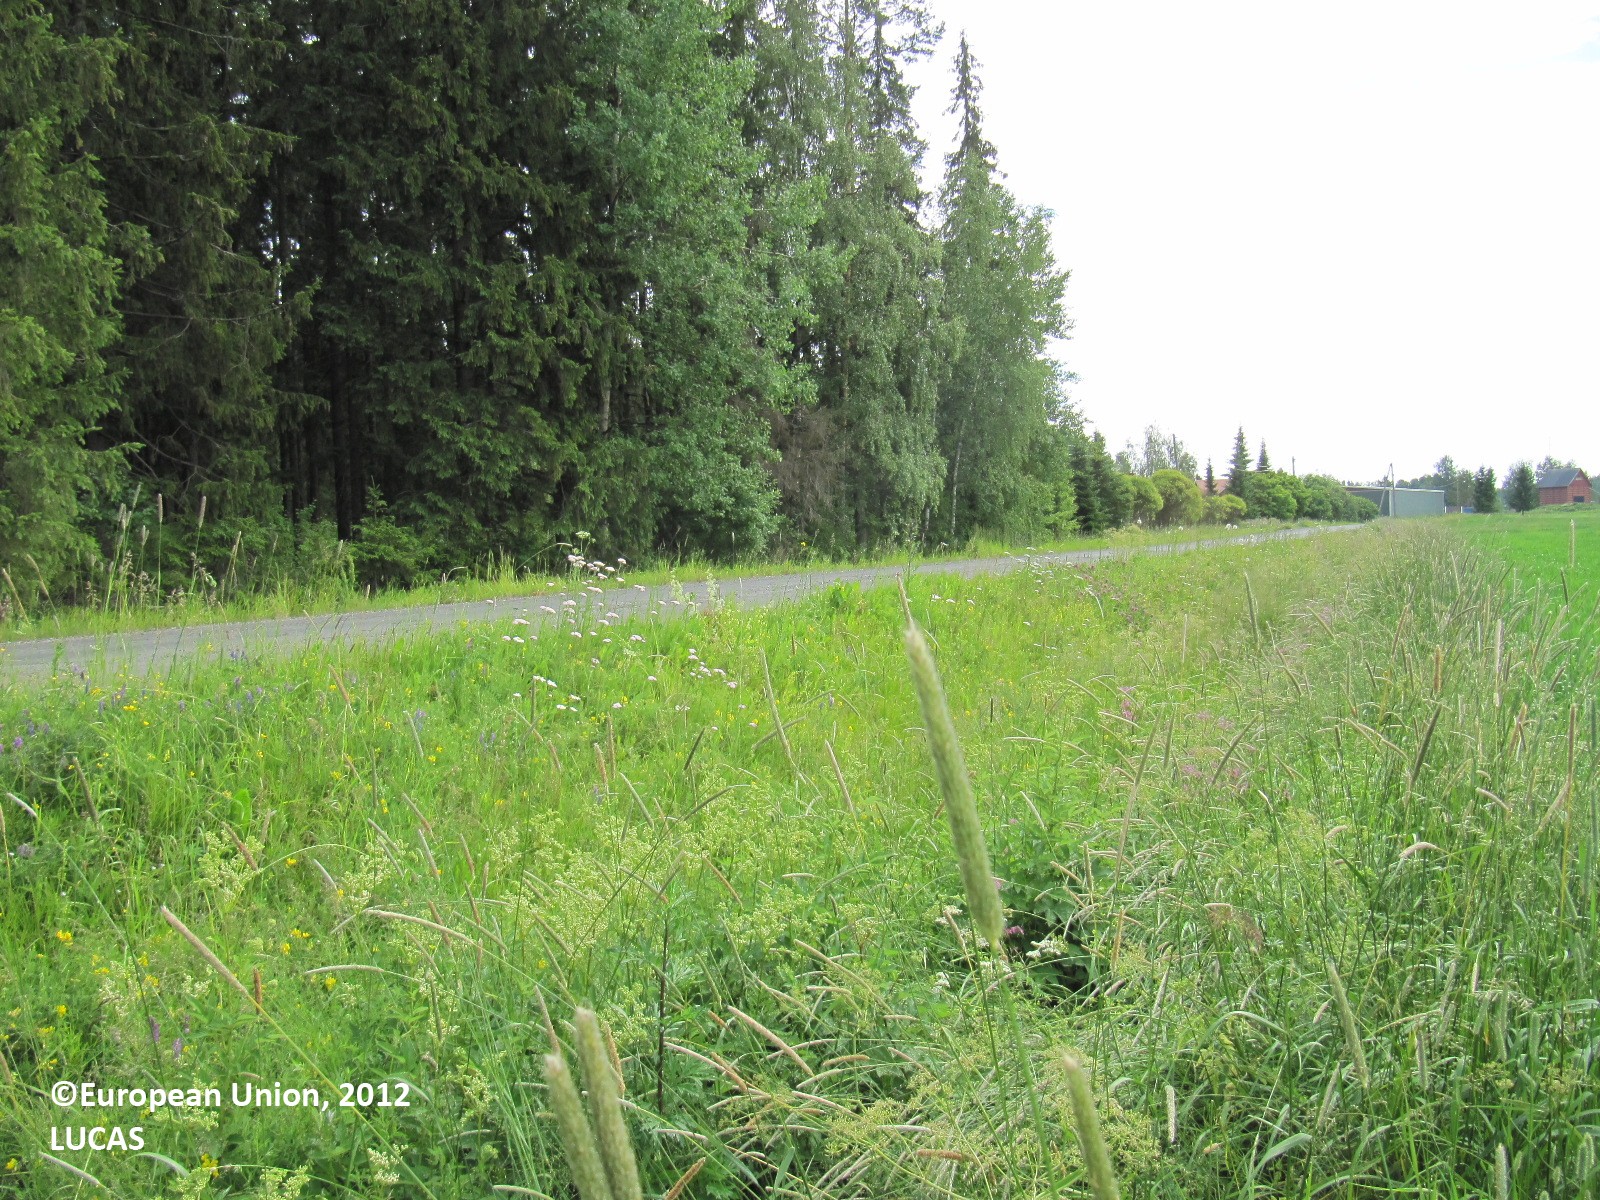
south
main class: Cropland
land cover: Common wheat
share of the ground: > 75 %
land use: Agriculture (excluding fallow land and kitchen gardens)
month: July
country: FI
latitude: 60.9511
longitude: 23.3555
